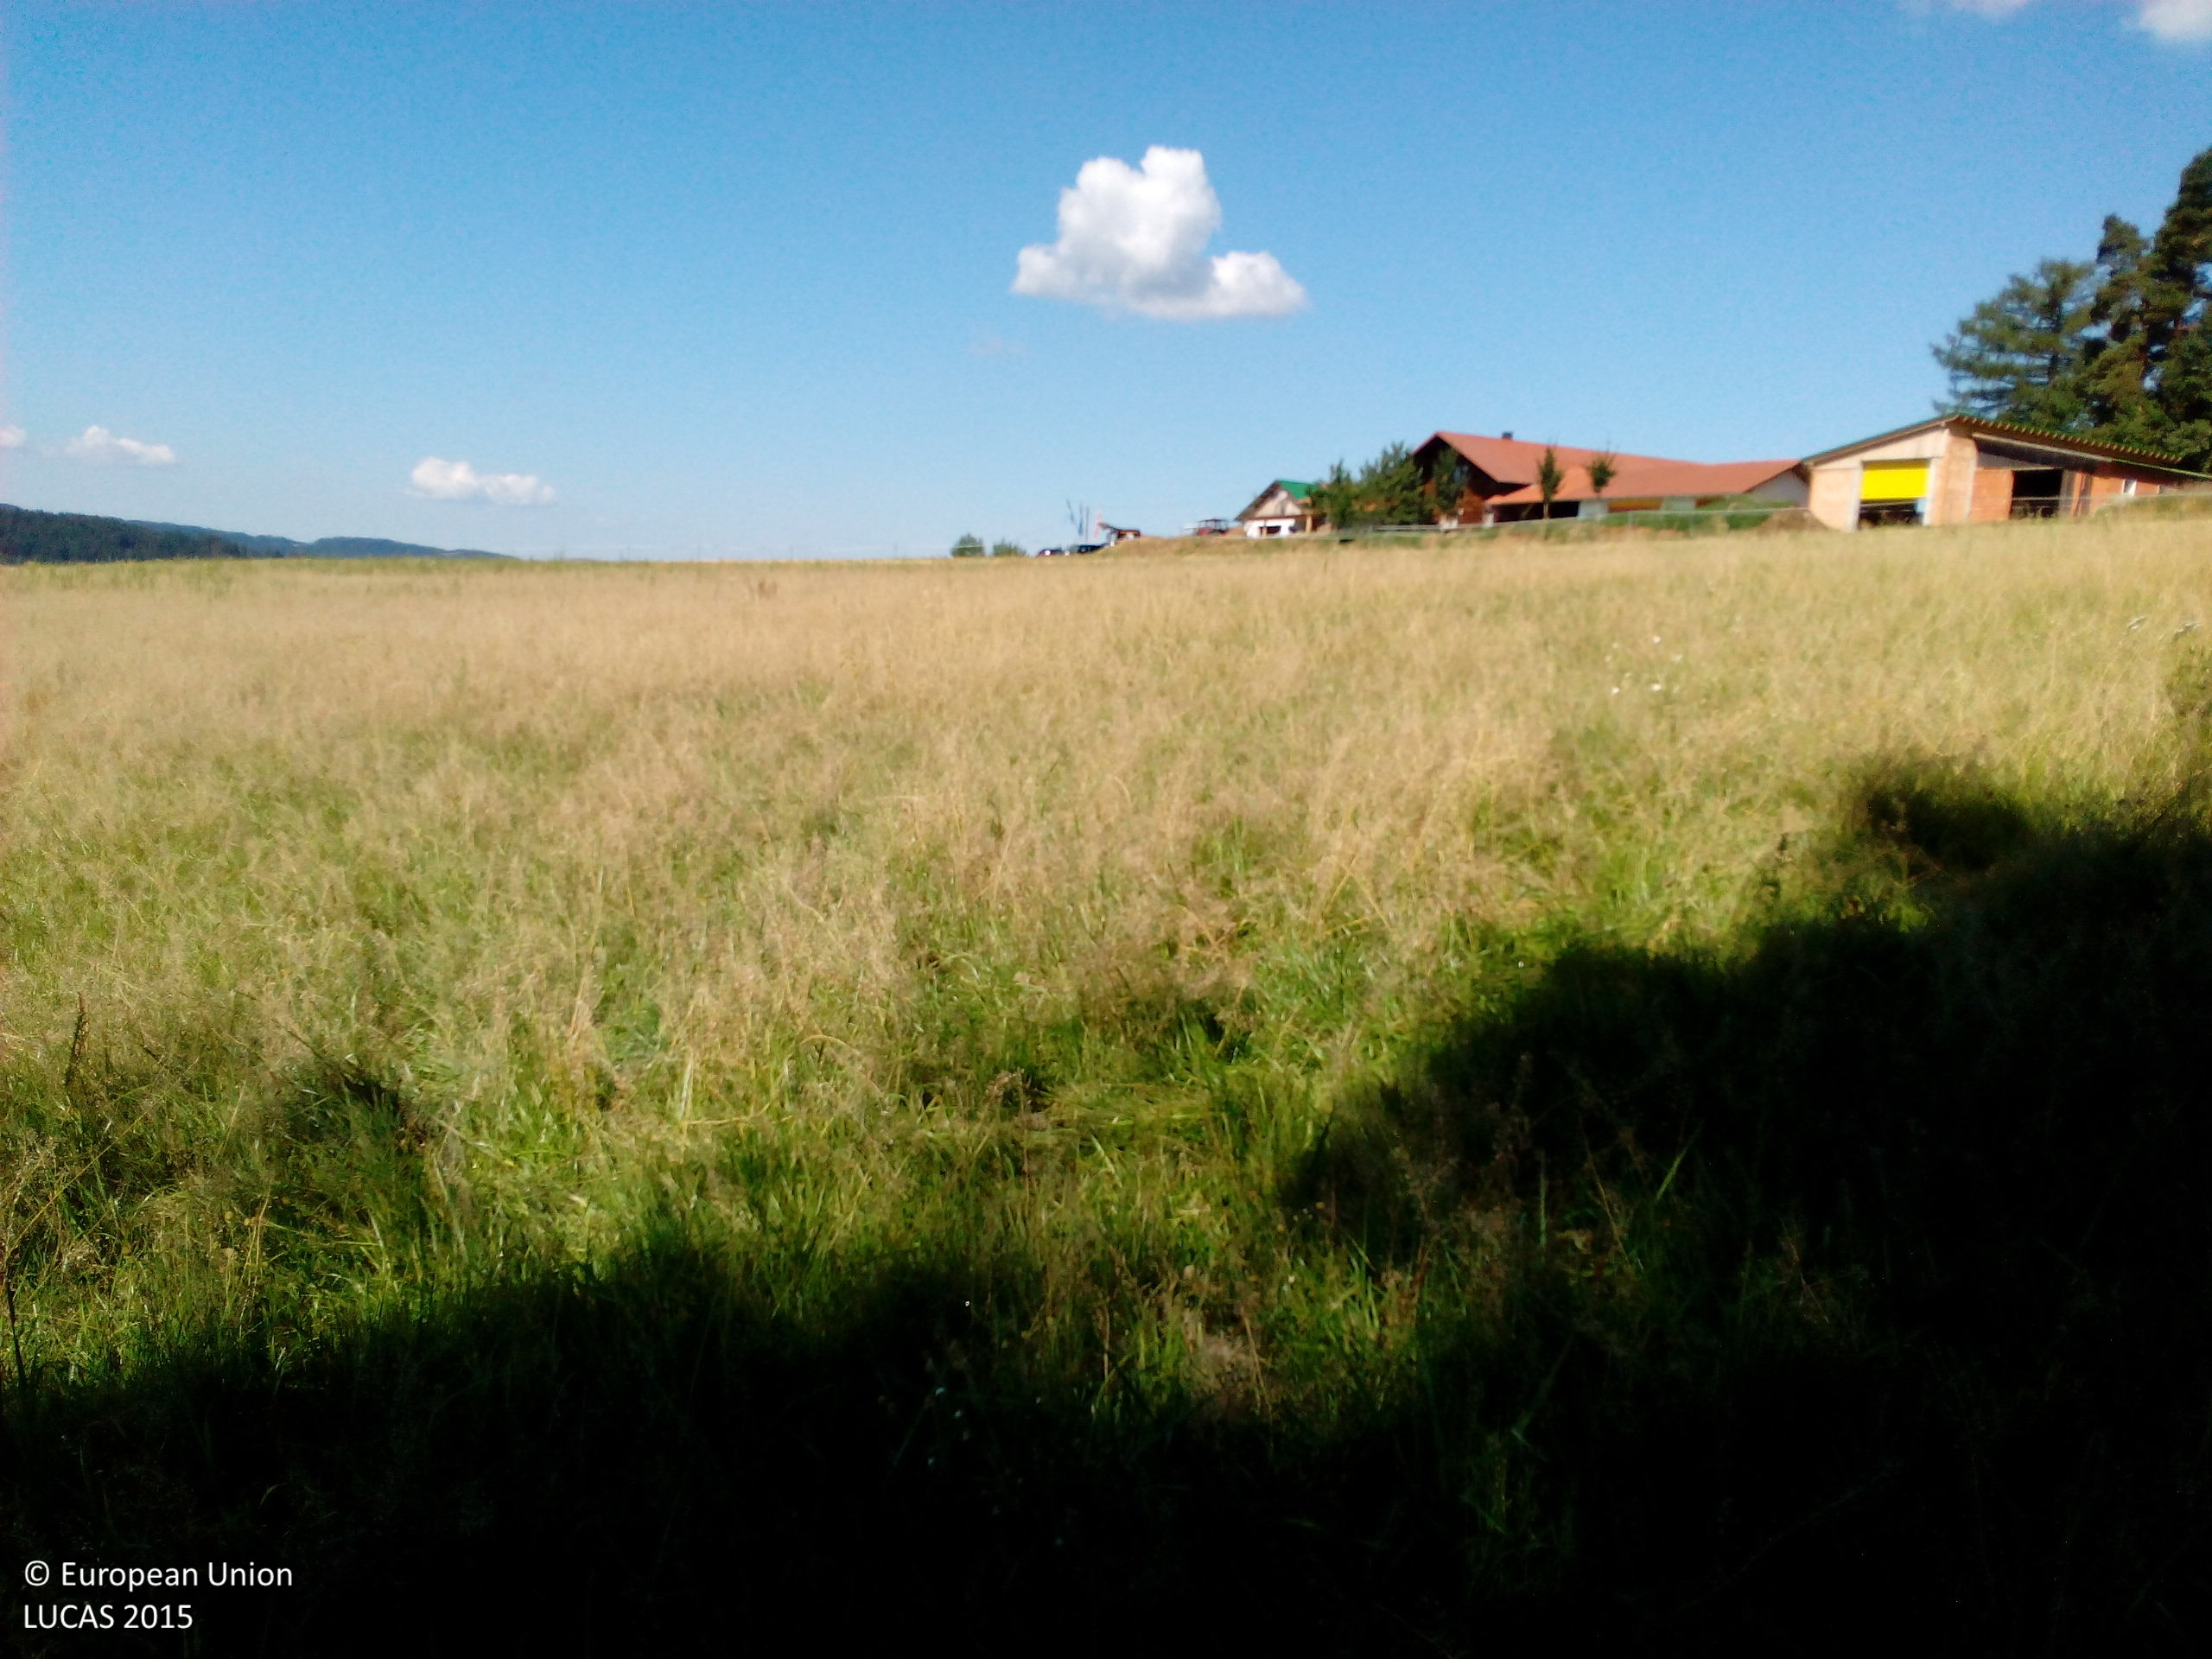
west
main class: Grassland
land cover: Grassland without tree/shrub cover
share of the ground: > 75 %
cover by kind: herbaceous plants 100 %
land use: Agriculture (excluding fallow land and kitchen gardens)
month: July
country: DE
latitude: 49.1757
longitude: 12.8940
